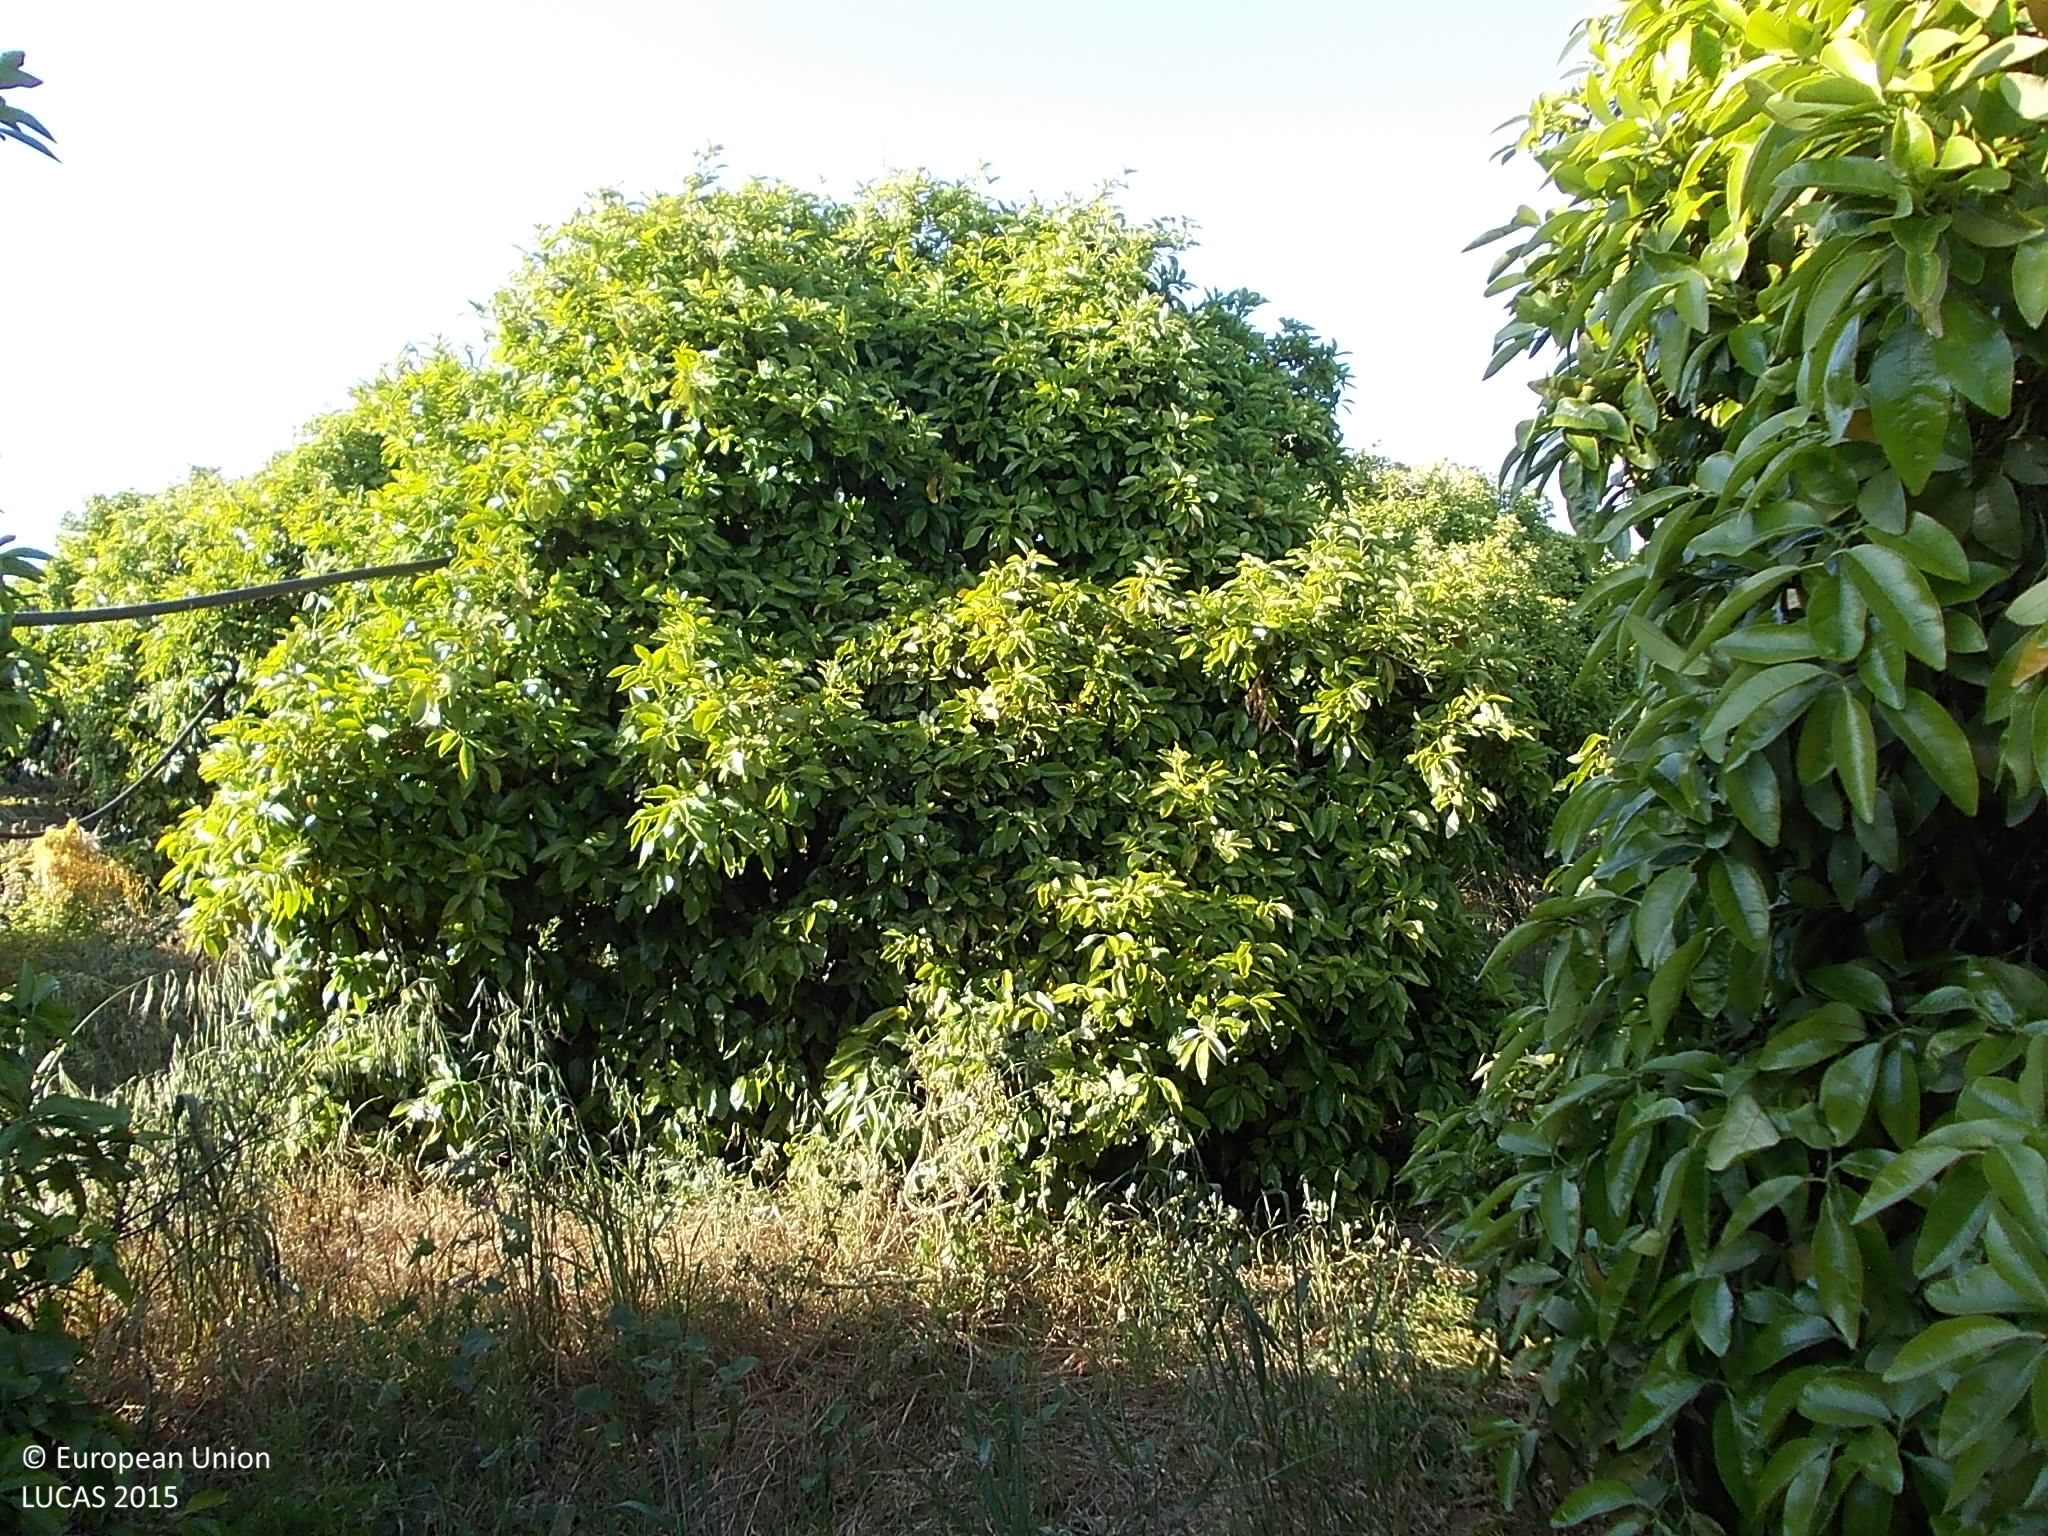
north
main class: Cropland
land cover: Oranges
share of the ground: > 75 %
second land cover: Spontaneously vegetated surfaces
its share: > 75 %
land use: Agriculture (excluding fallow land and kitchen gardens)
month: April
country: CY
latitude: 34.6850
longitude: 32.9862
